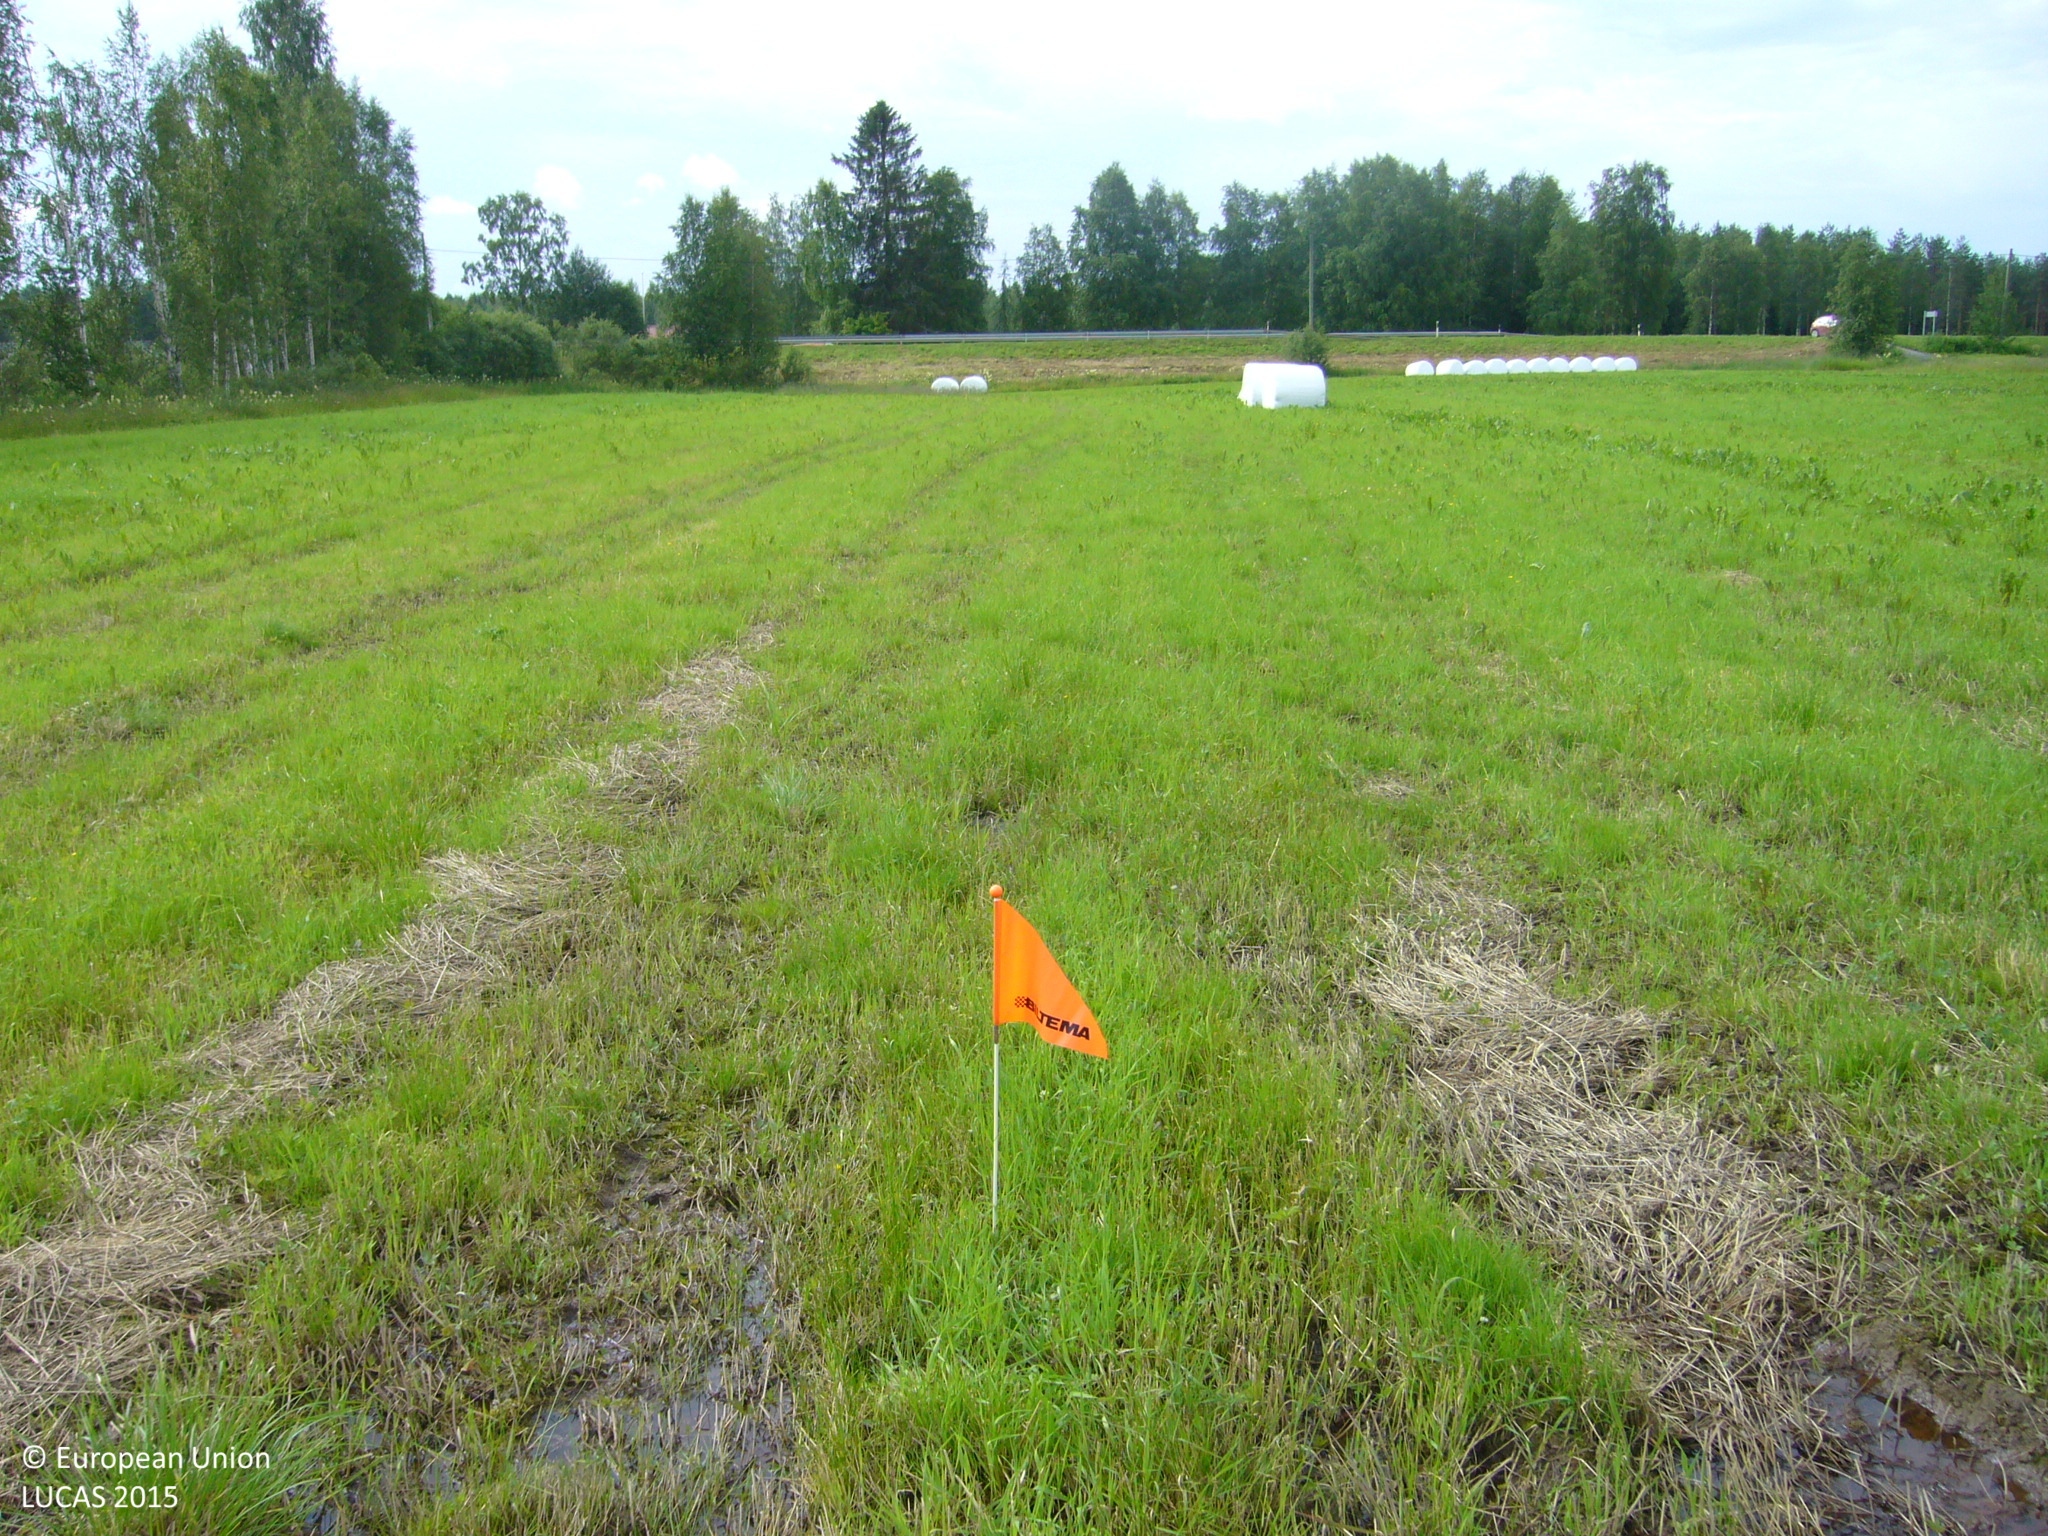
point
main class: Cropland
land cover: Temporary grasslands
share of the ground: > 75 %
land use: Agriculture (excluding fallow land and kitchen gardens)
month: July
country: FI
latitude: 63.9883
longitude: 25.6104
